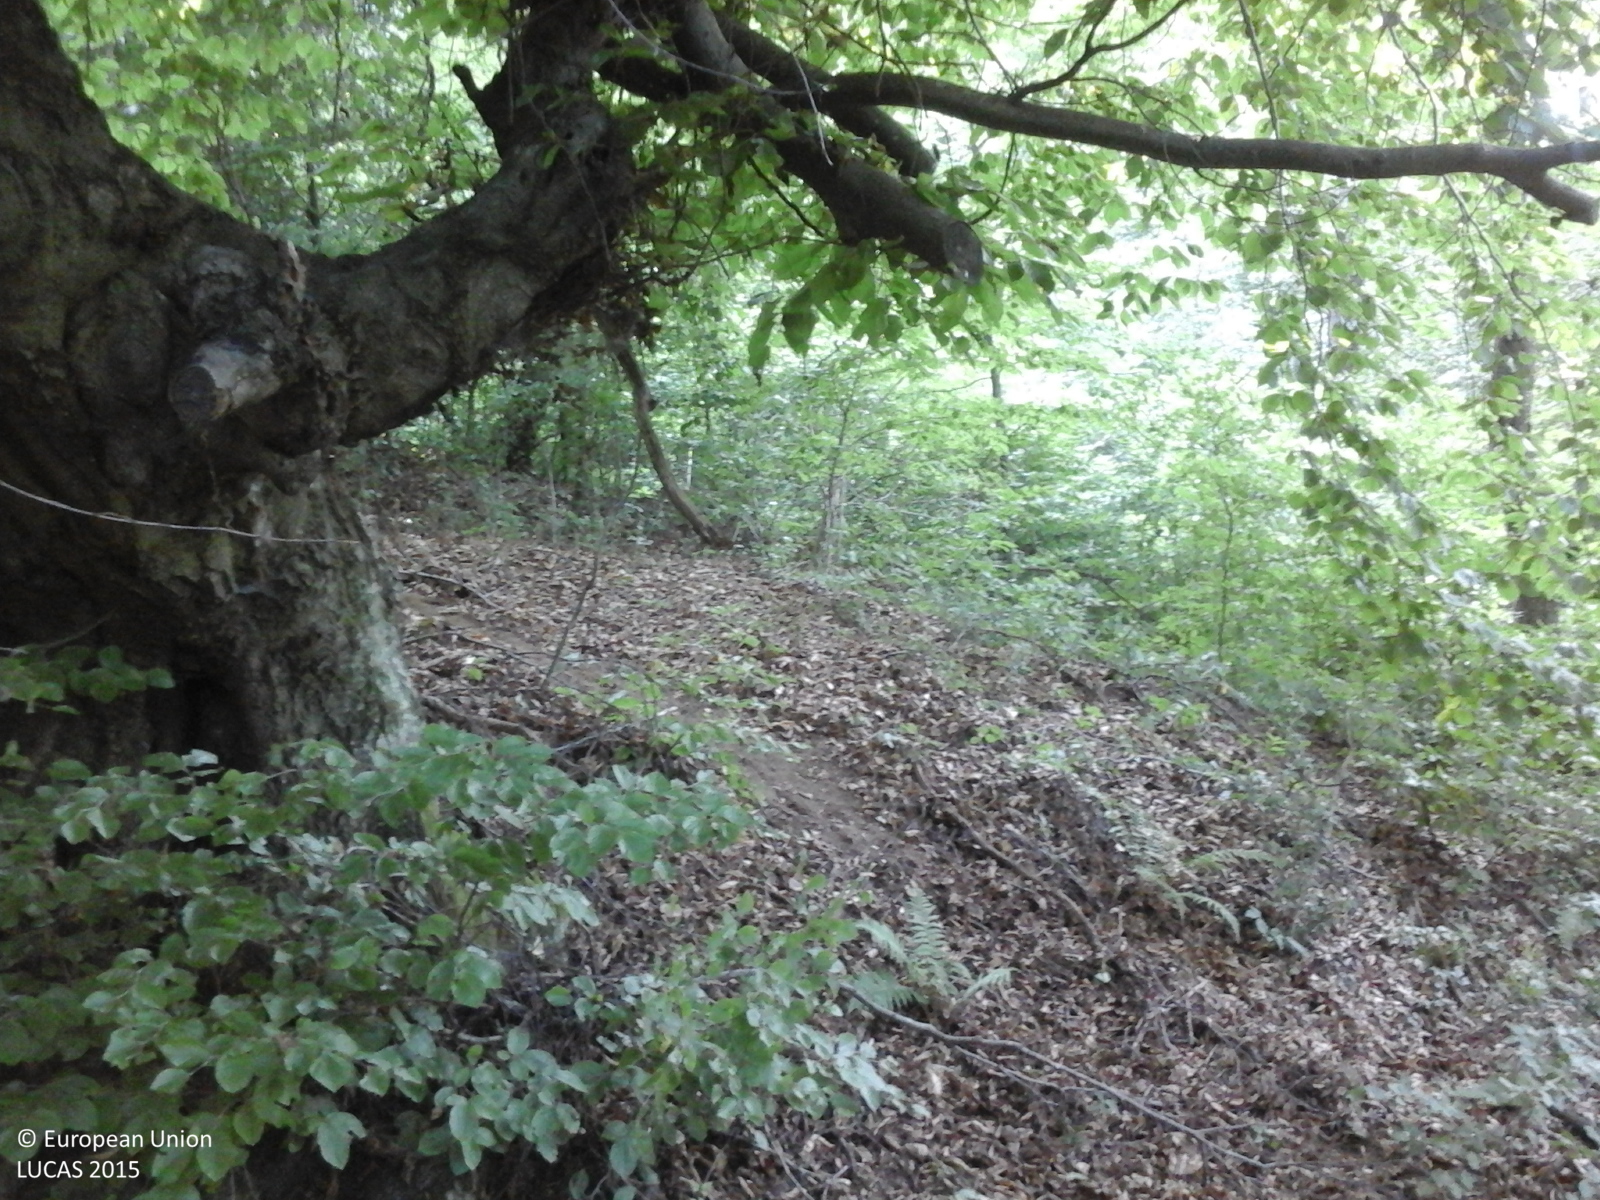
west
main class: Woodland
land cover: Broadleaved woodland
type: beech forest
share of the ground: > 75 %
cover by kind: broadleaved forest trees 100 %
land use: Forestry
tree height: > 5 m
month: July
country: RO
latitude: 45.0619
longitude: 24.7748
